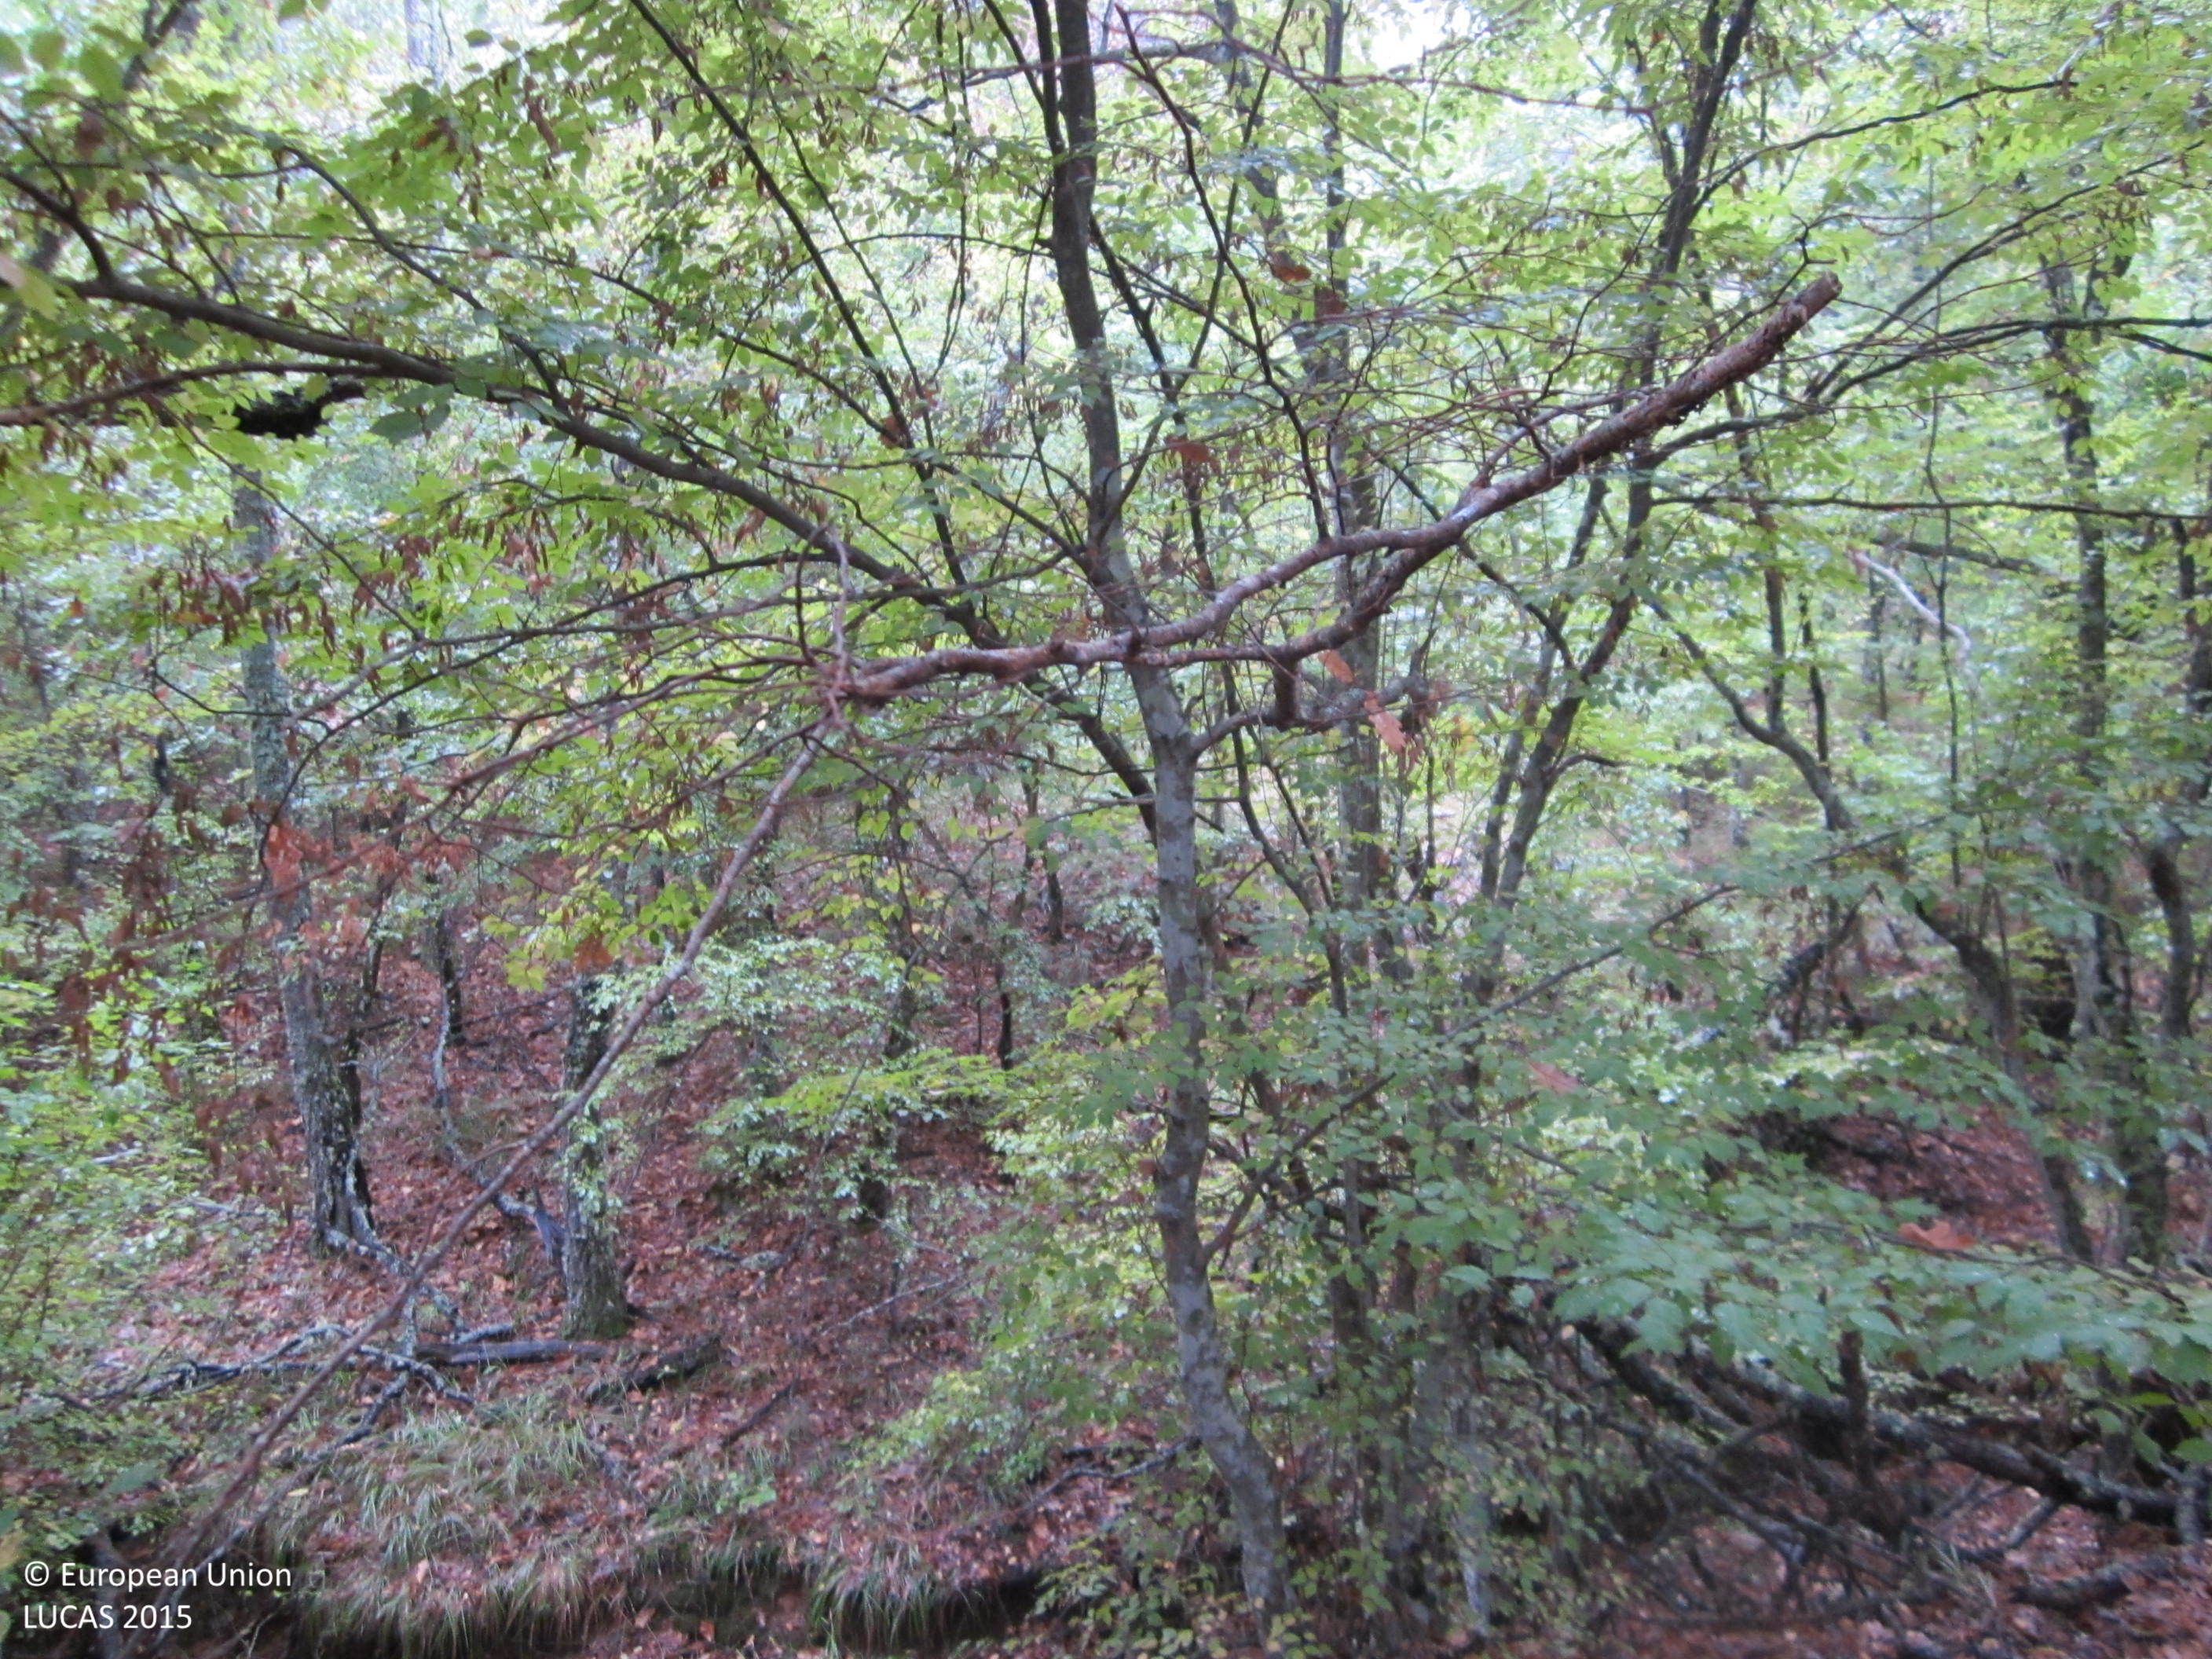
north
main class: Woodland
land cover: Pine dominated mixed woodland
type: hemiboreal forest and nemoral coniferous forest and mixed broadleaved-coniferous forest
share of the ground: > 75 %
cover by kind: coniferous forest trees 60 %, broadleaved forest trees 25 %, unconsolidated bare surface 10 %, herbaceous plants 5 %
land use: Forestry
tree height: > 5 m
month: October
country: BG
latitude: 42.1508
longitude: 27.2789
